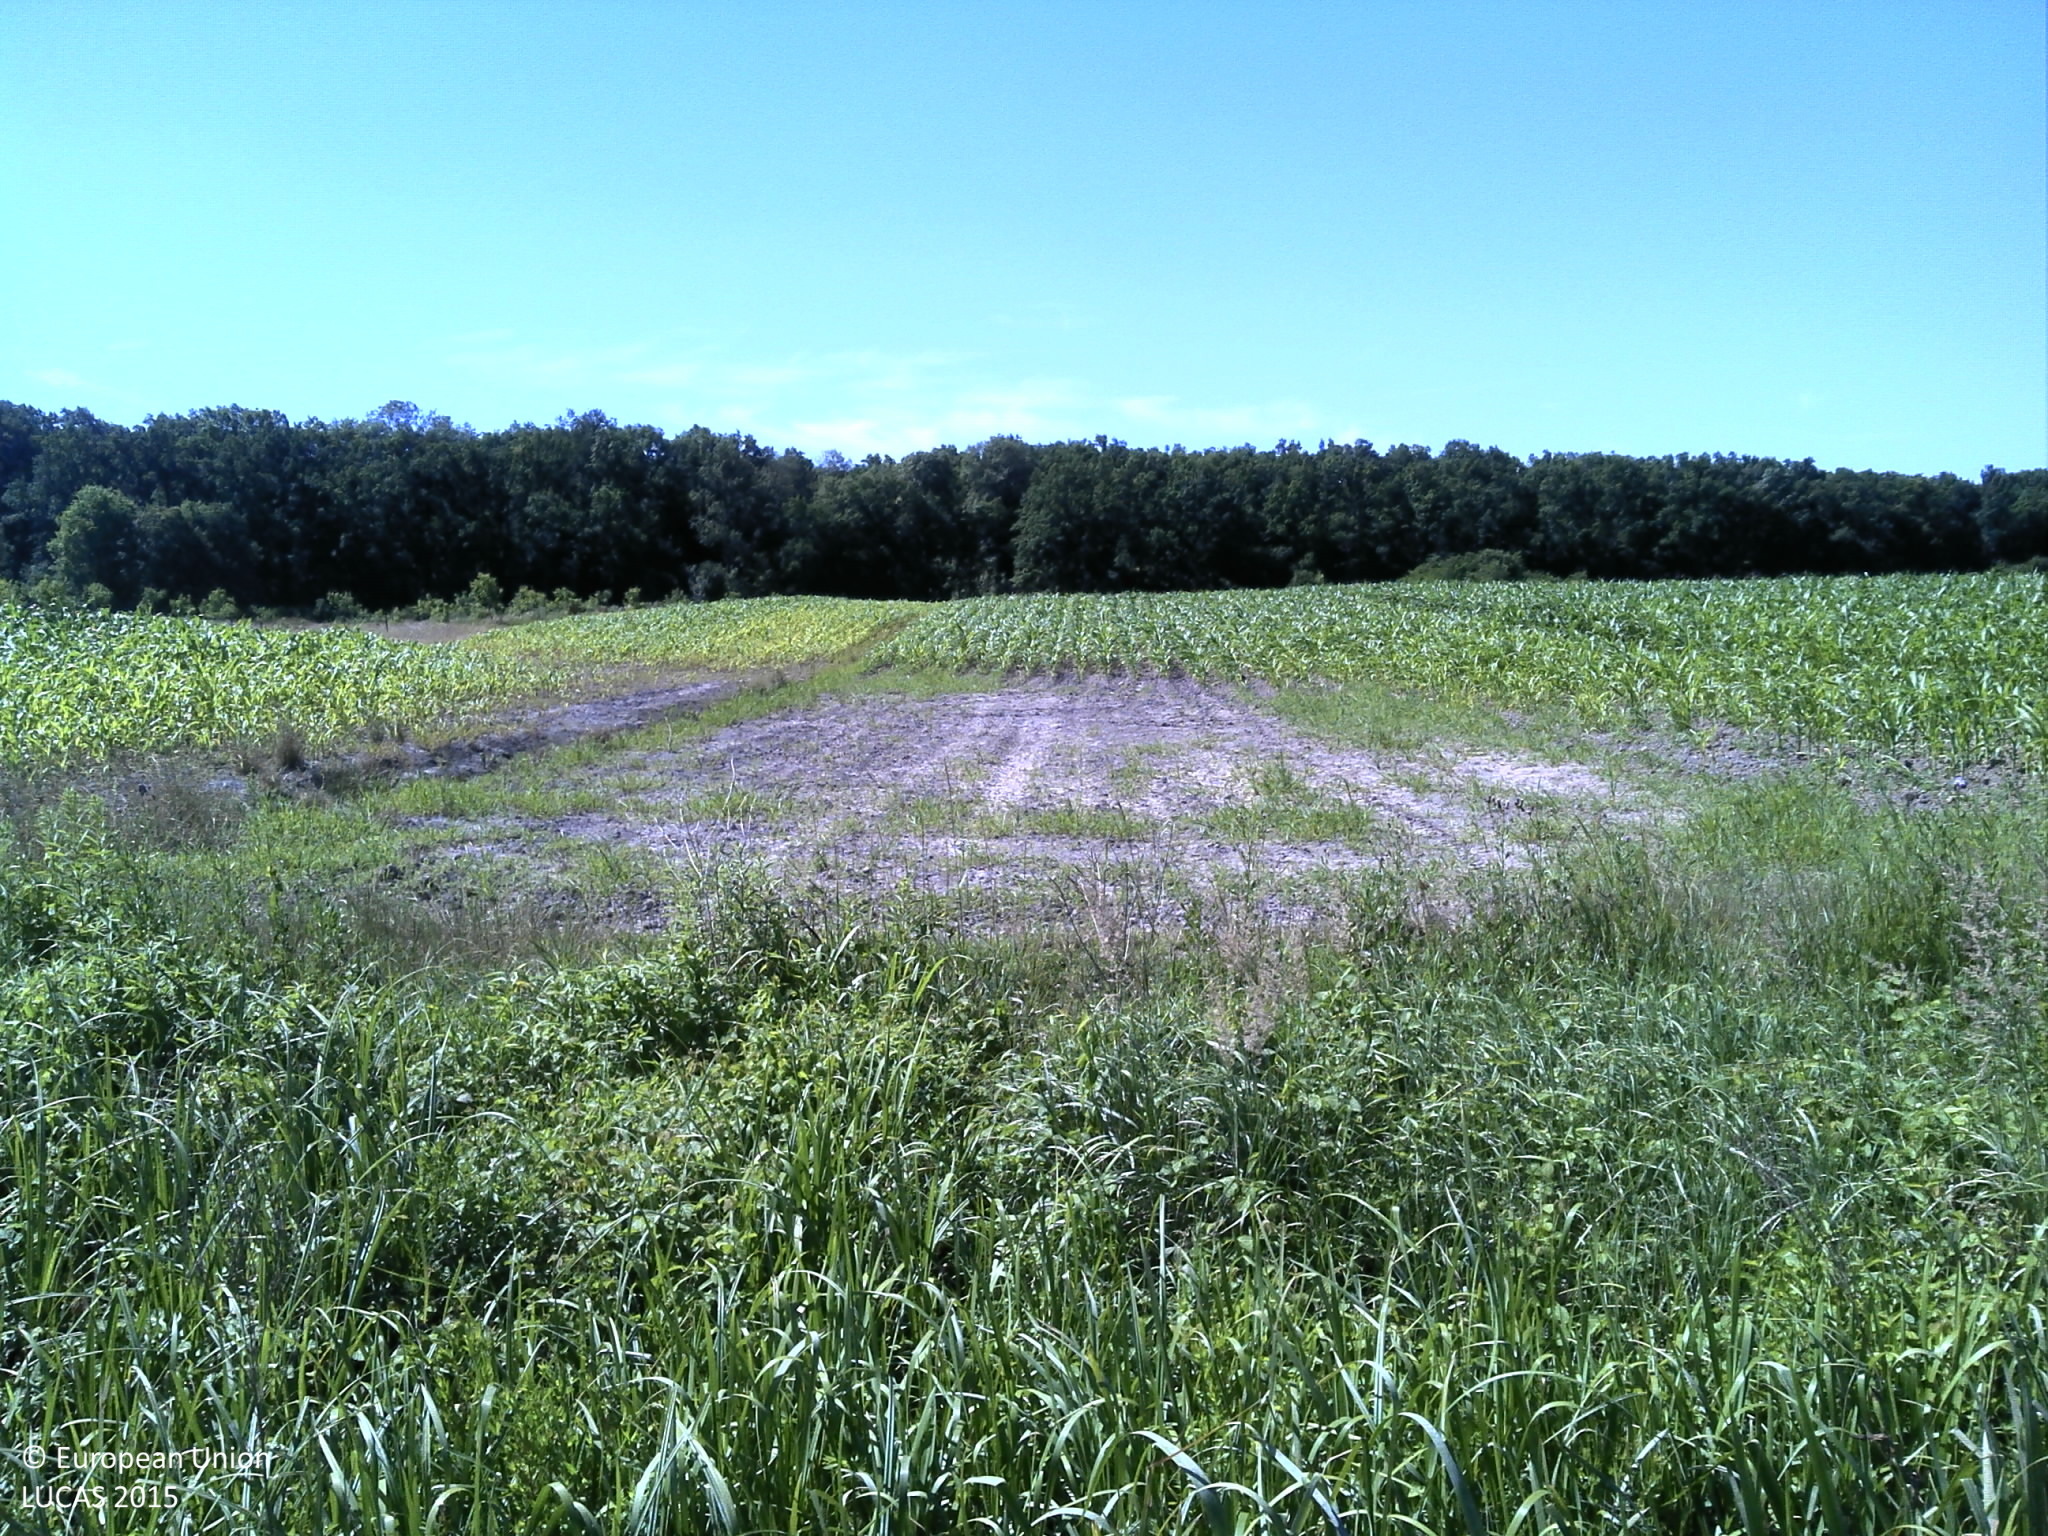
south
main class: Grassland
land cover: Grassland without tree/shrub cover
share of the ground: > 75 %
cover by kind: herbaceous plants 100 %
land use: Semi-natural and natural areas not in use
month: June
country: HR
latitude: 45.7465
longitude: 17.9610
